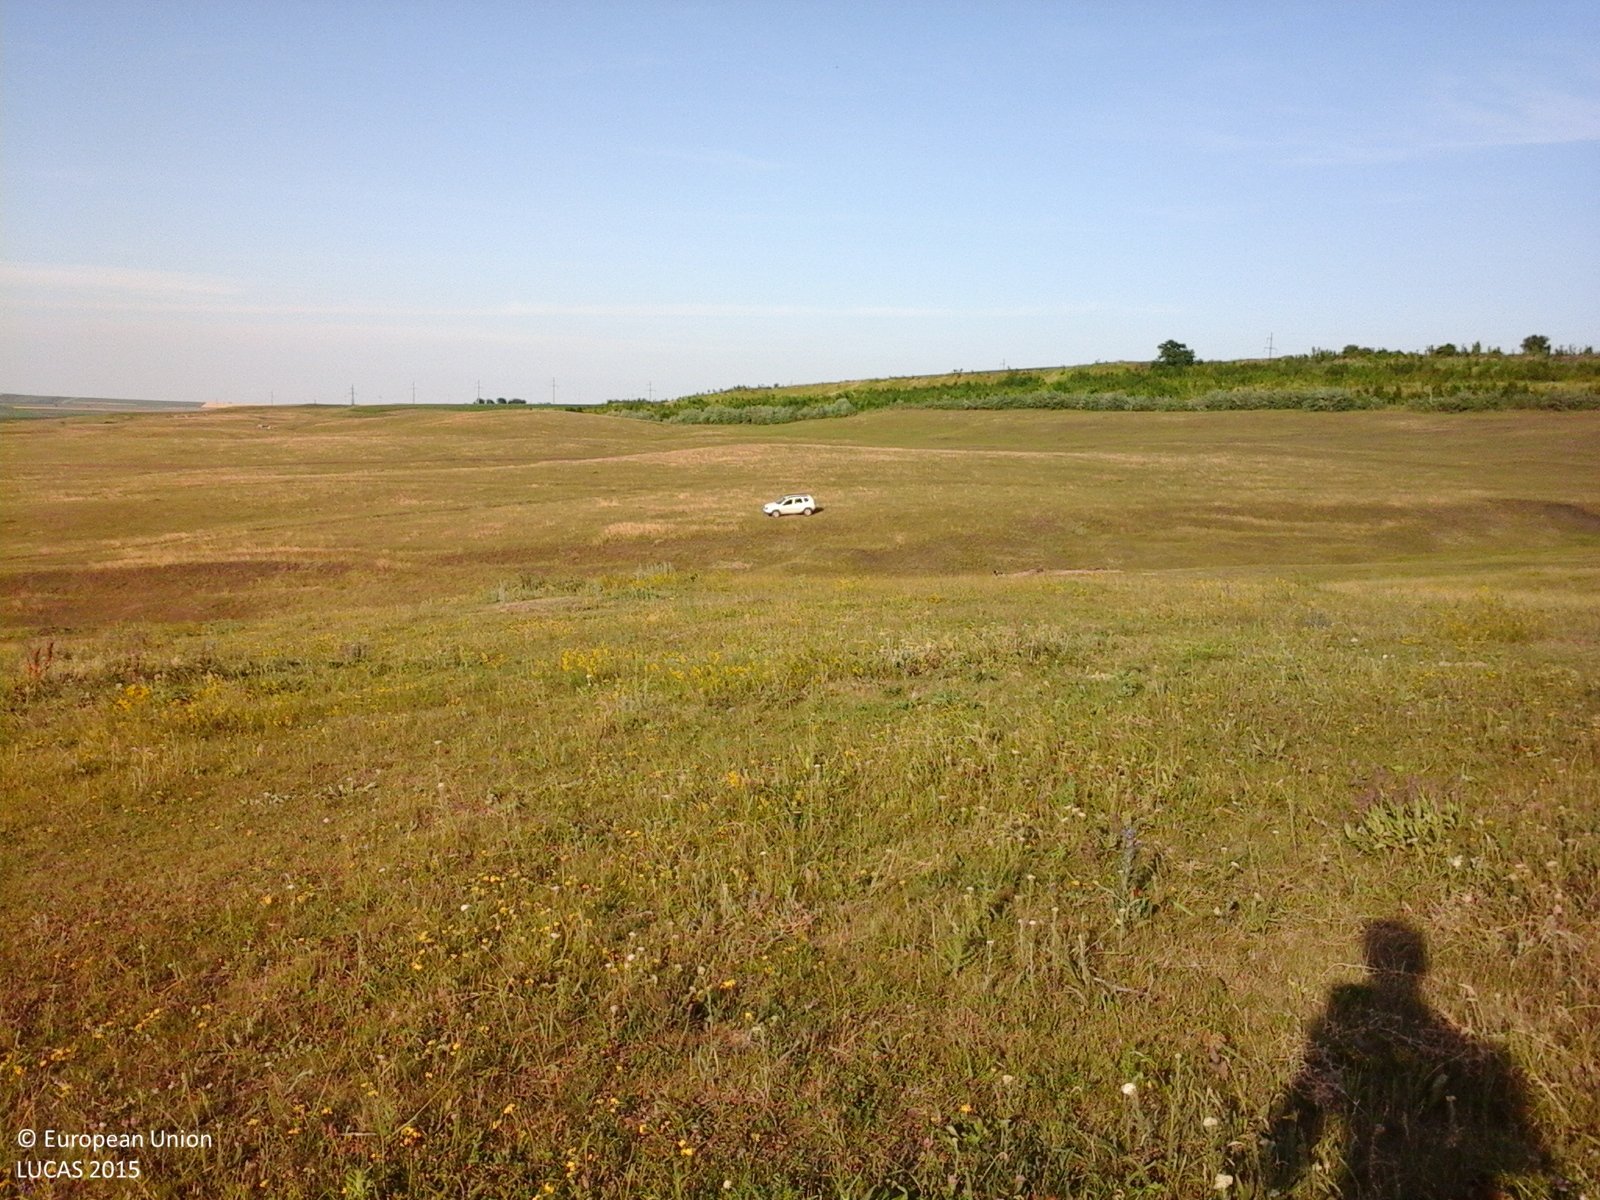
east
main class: Grassland
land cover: Grassland without tree/shrub cover
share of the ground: > 75 %
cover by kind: herbaceous plants 100 %
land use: Agriculture (excluding fallow land and kitchen gardens)
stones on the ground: < 10 %
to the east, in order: Grassland without tree/shrub cover; Tracks; Grassland without tree/shrub cover
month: June
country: RO
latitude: 48.0224
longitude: 26.9321
